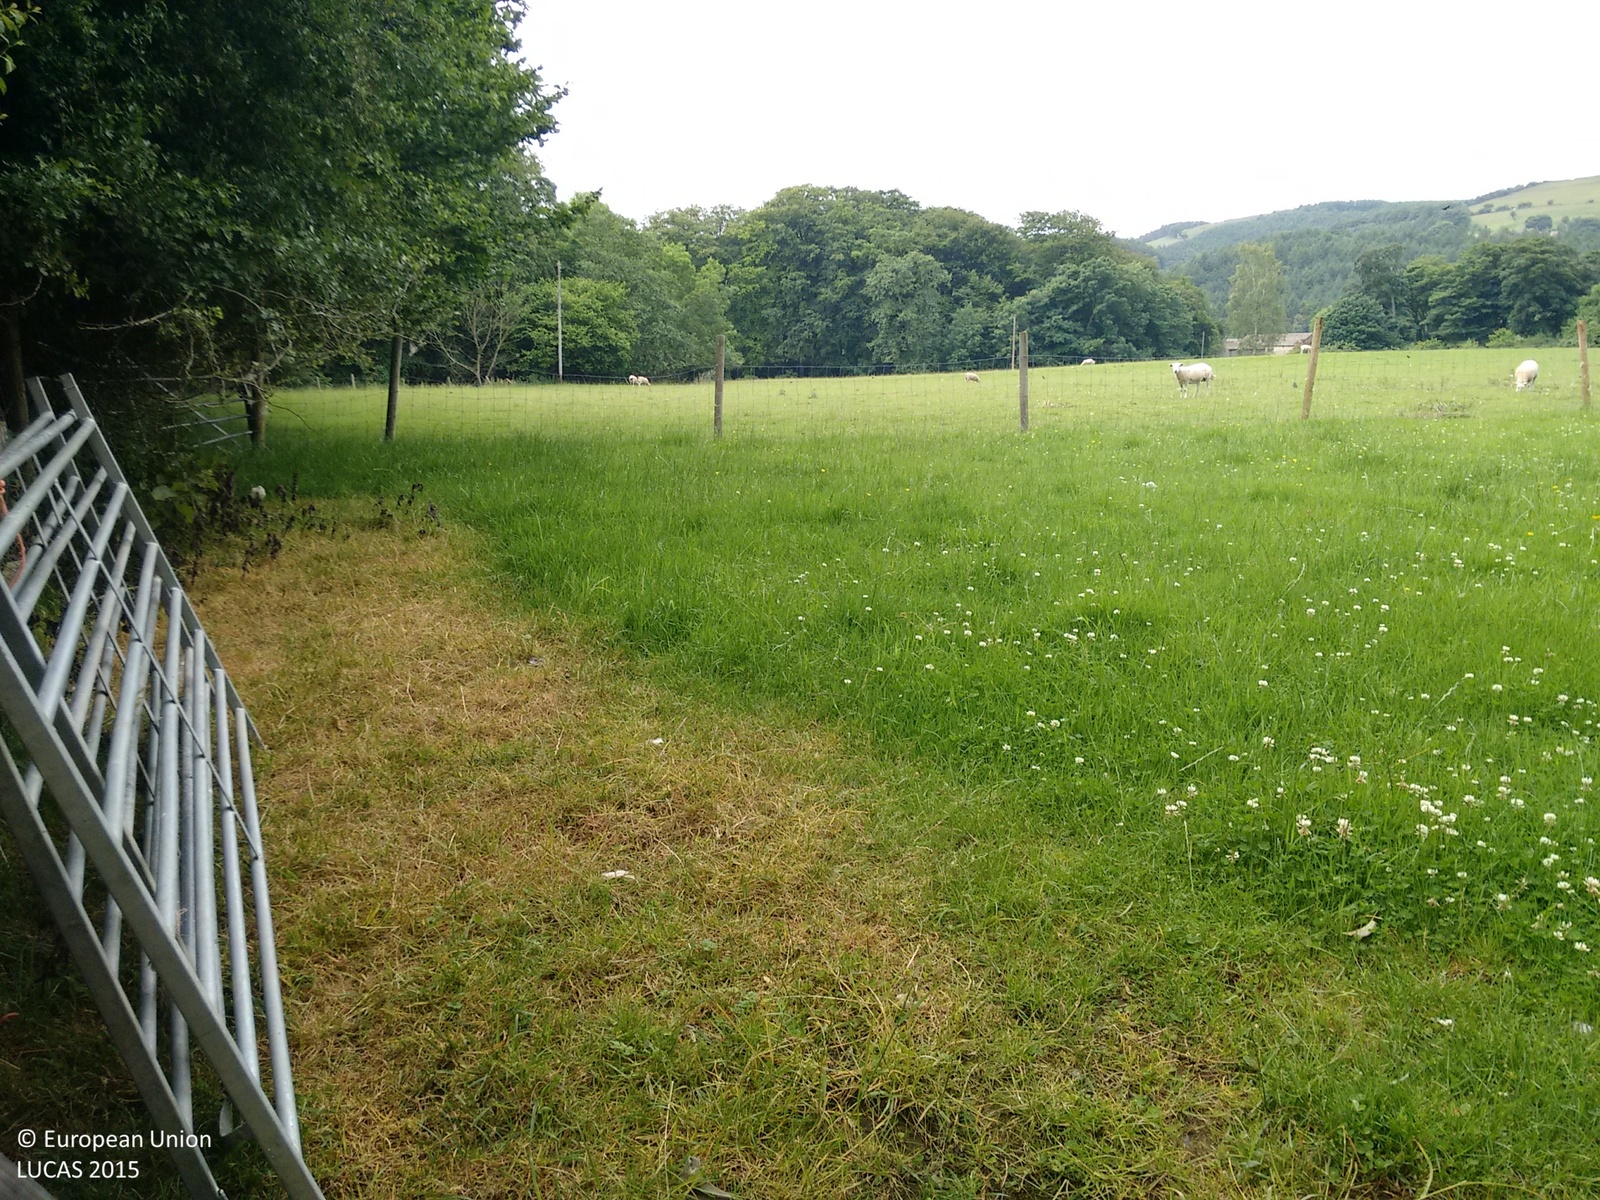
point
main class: Grassland
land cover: Grassland without tree/shrub cover
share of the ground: > 75 %
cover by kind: herbaceous plants 100 %
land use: Agriculture (excluding fallow land and kitchen gardens)
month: June
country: GB
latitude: 53.3272
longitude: -1.6587
